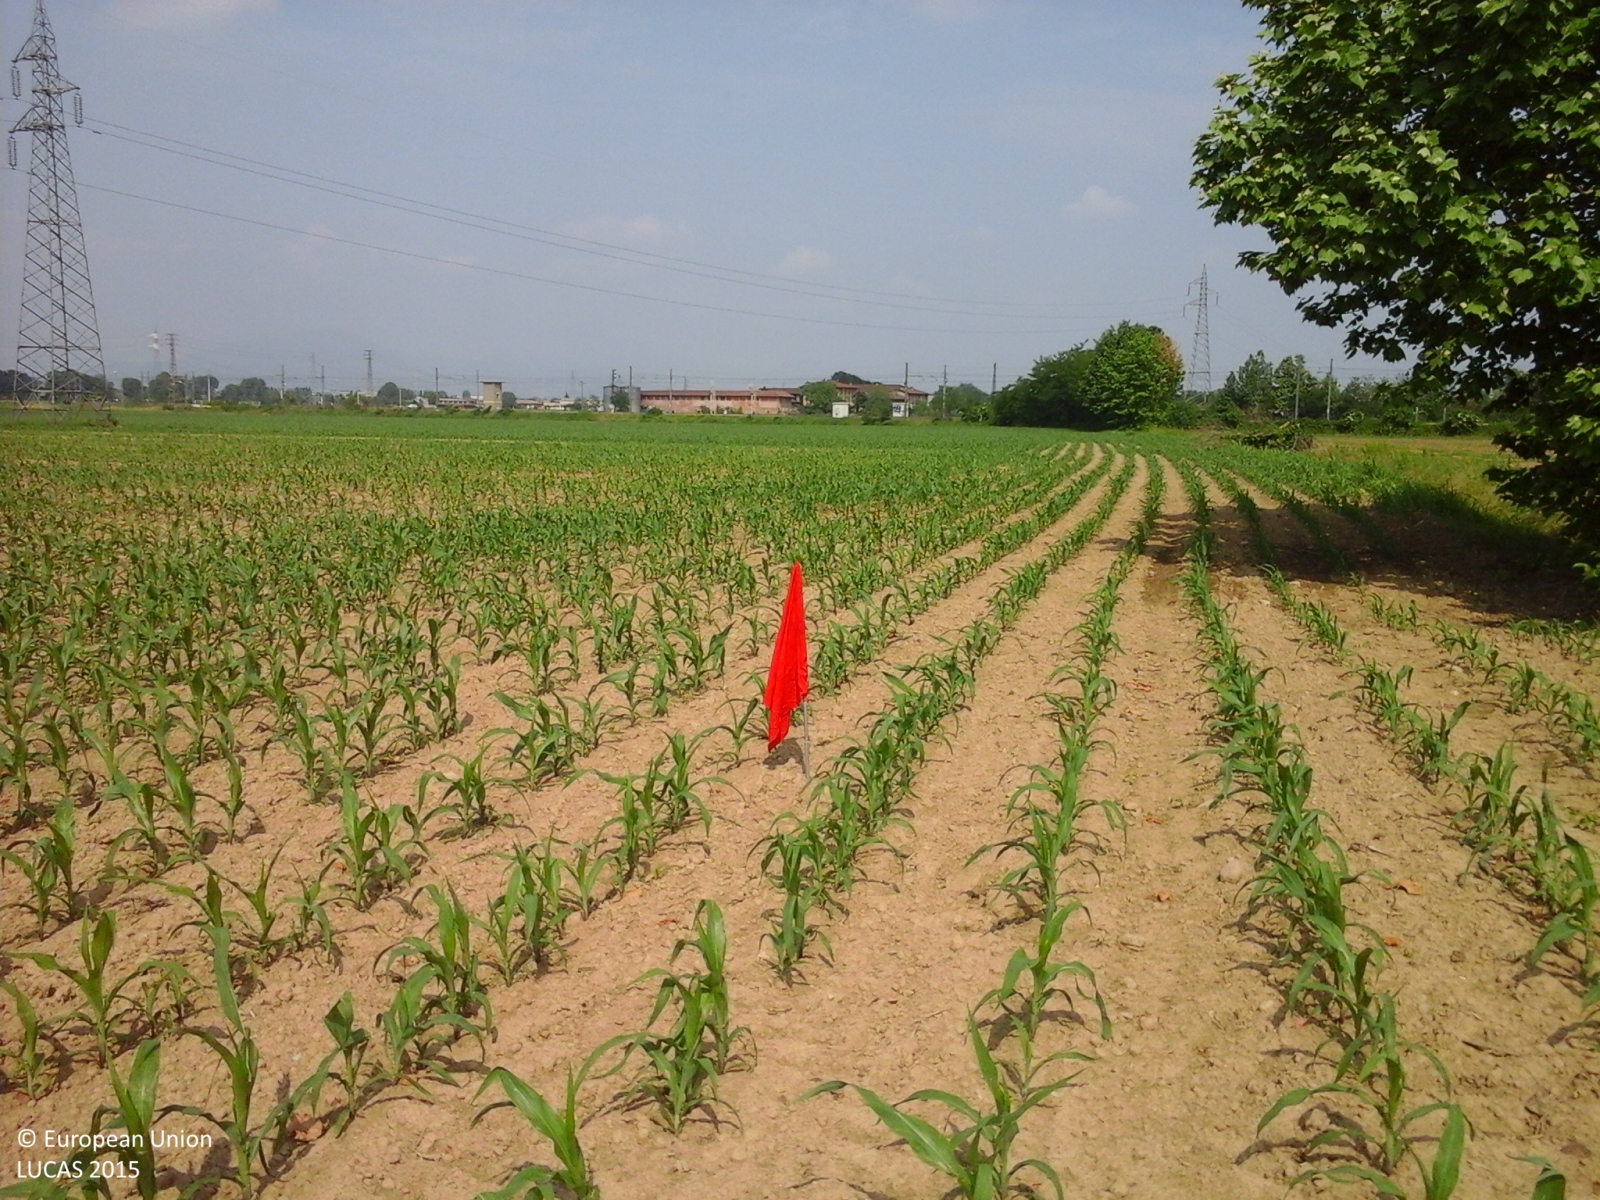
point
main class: Cropland
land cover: Maize
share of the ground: 10 - 25 %
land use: Agriculture (excluding fallow land and kitchen gardens)
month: May
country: IT
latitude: 45.6299
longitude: 9.6286
